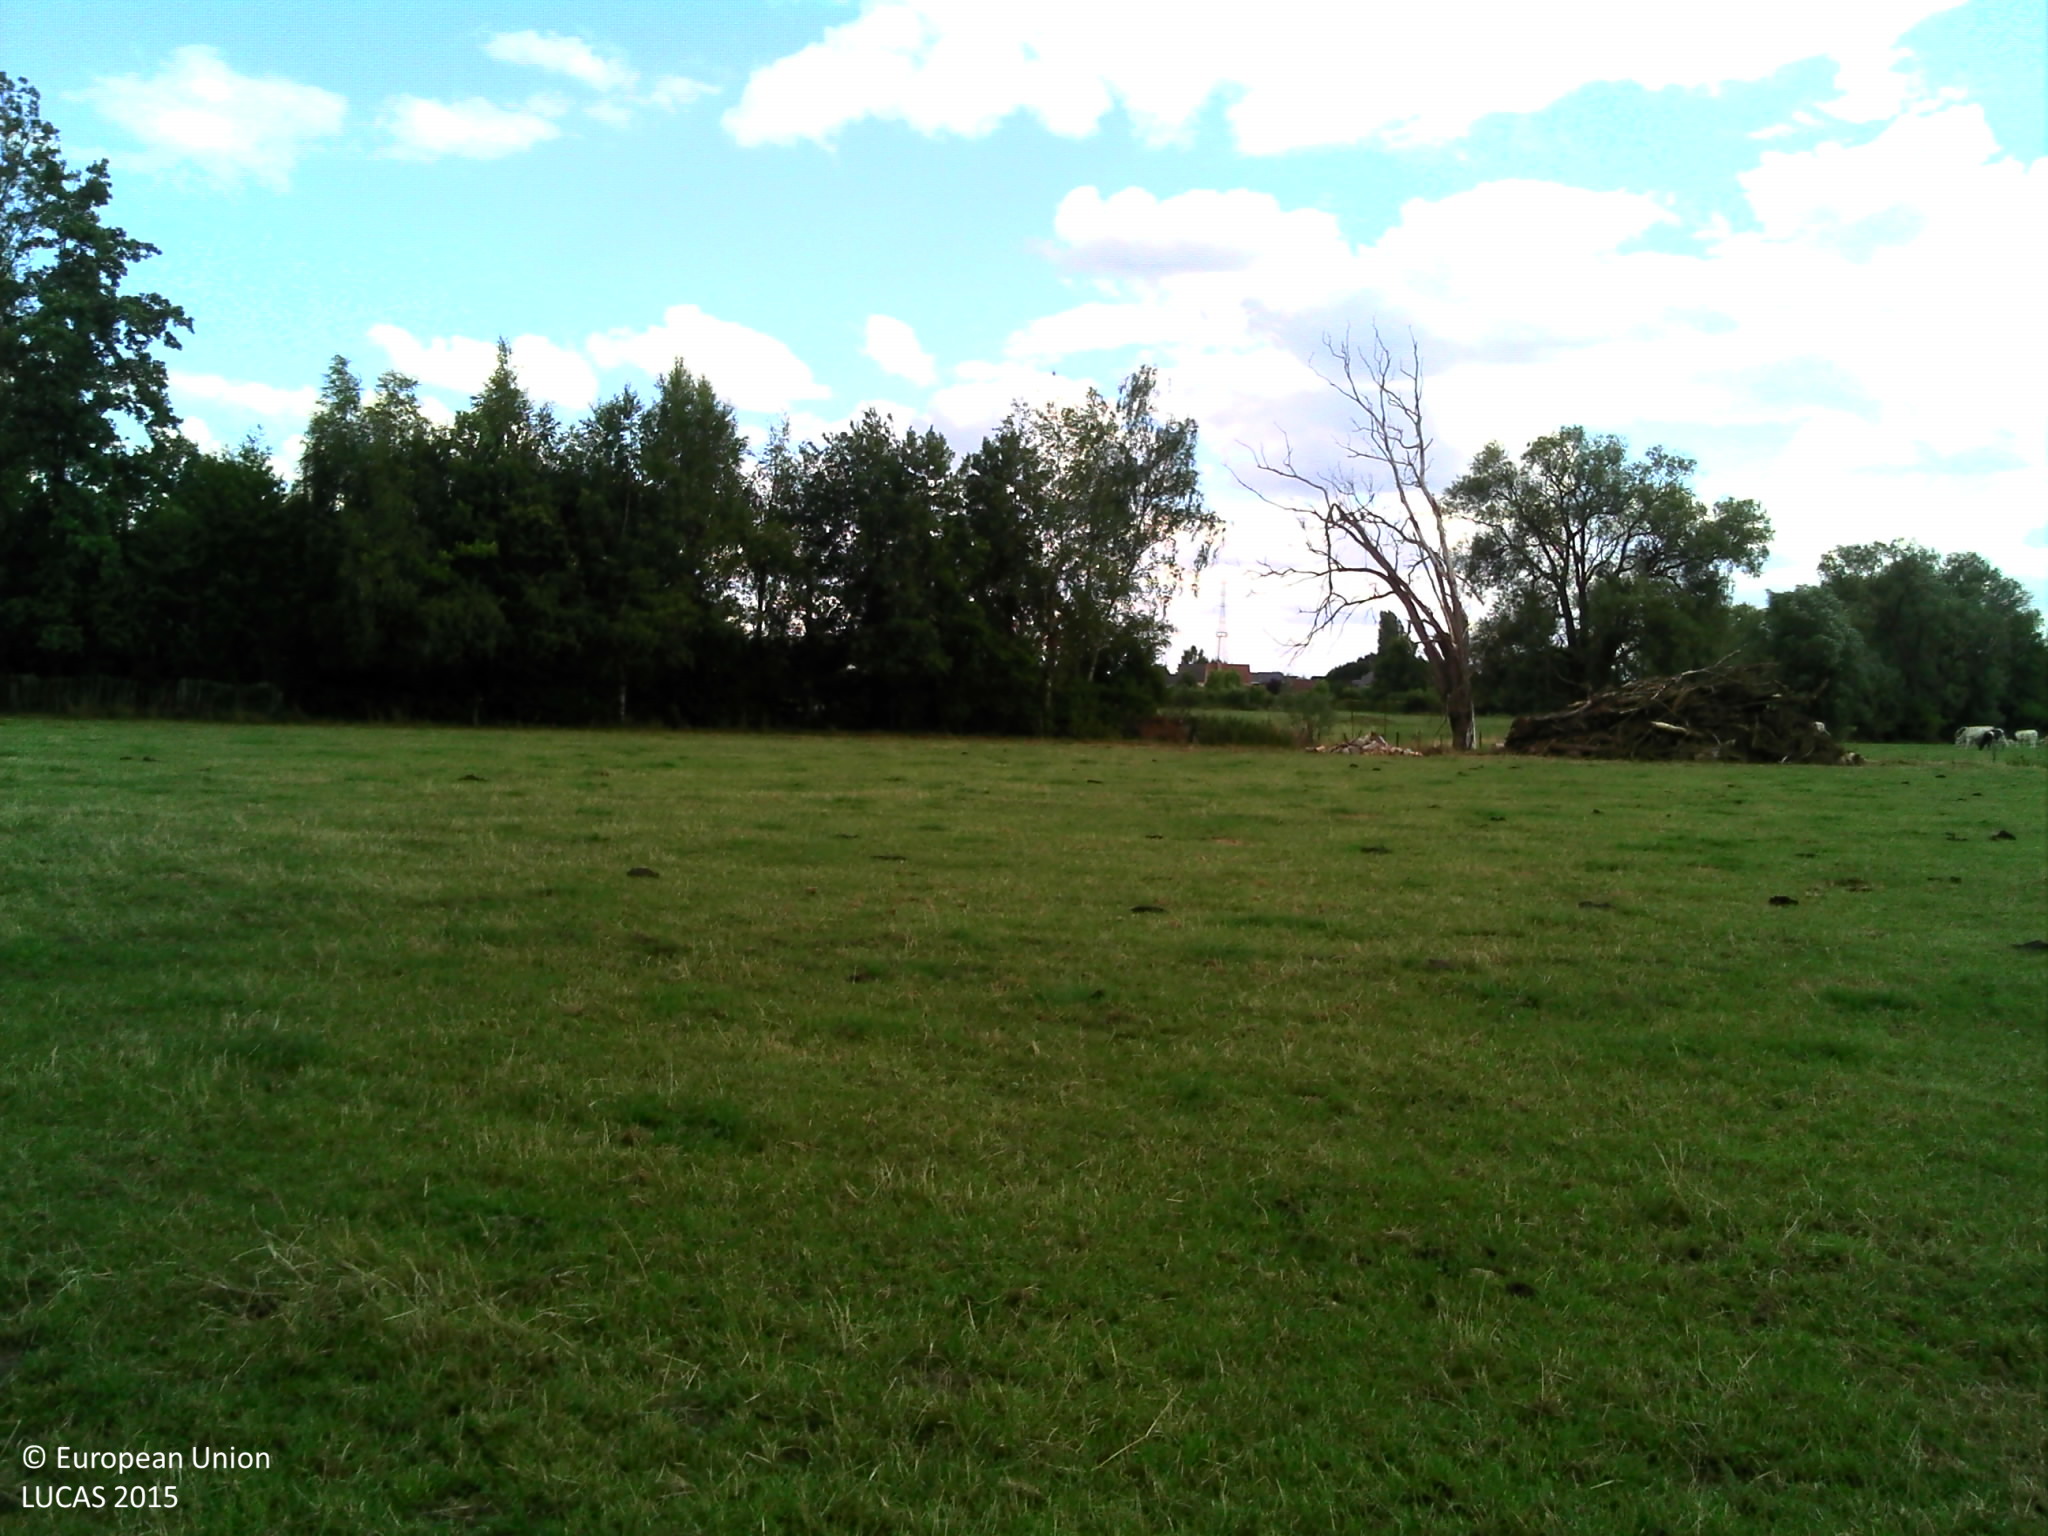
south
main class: Grassland
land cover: Grassland without tree/shrub cover
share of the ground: > 75 %
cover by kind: herbaceous plants 100 %
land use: Agriculture (excluding fallow land and kitchen gardens)
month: July
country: BE
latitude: 51.0981
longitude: 4.5266
